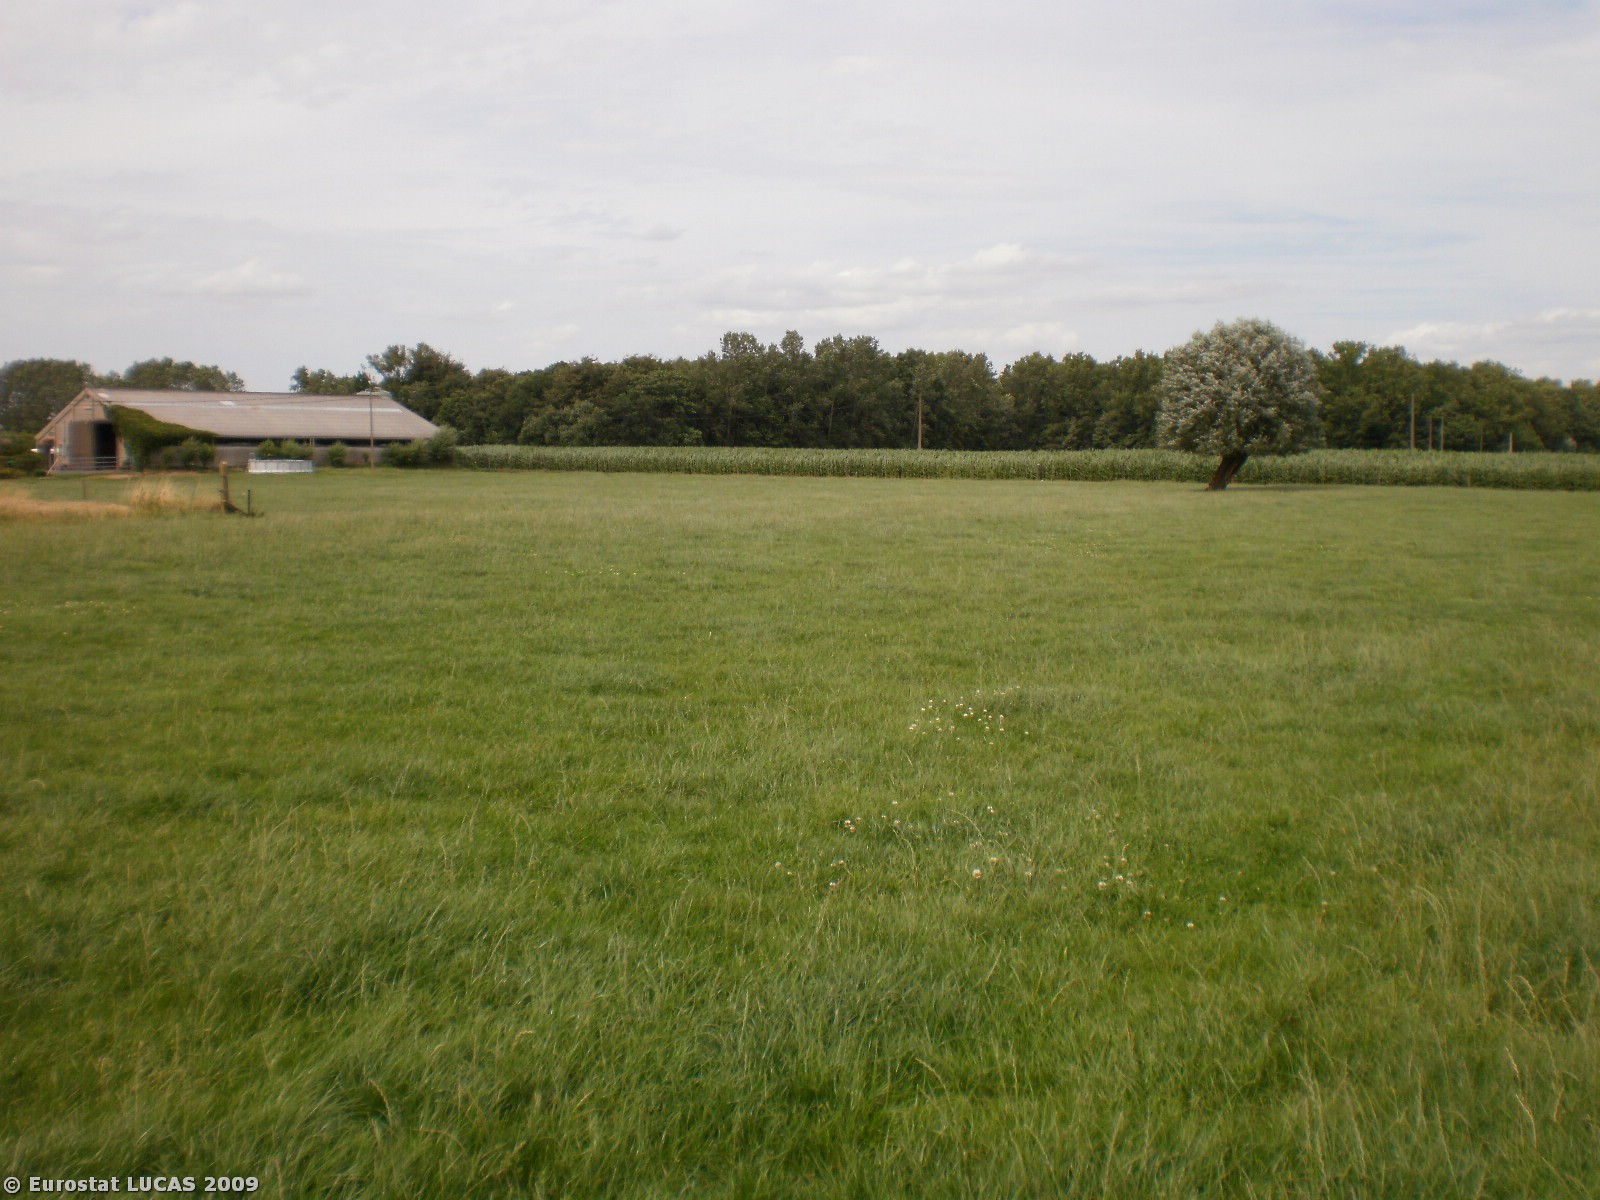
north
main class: Grassland
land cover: Grassland without tree/shrub cover
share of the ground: > 75 %
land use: Agriculture (excluding fallow land and kitchen gardens)
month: July
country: BE
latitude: 50.8583
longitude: 2.7862
